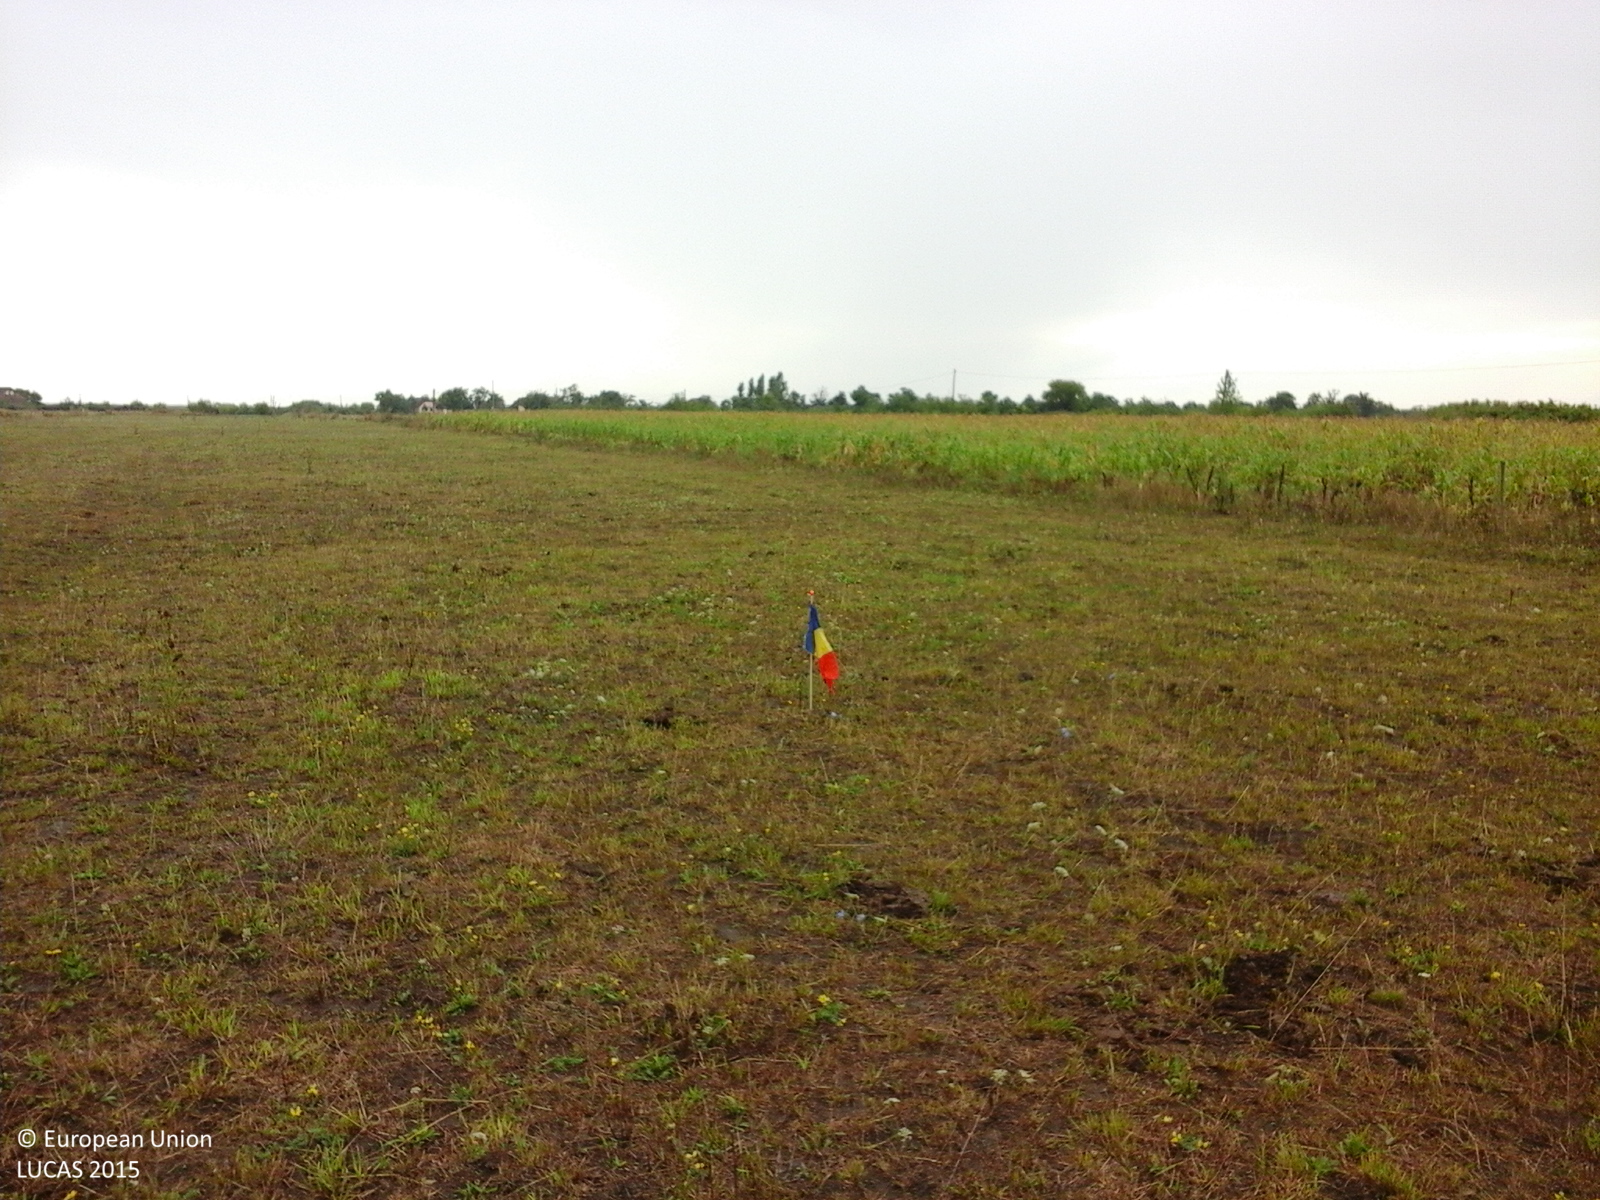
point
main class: Grassland
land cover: Grassland without tree/shrub cover
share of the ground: > 75 %
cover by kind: herbaceous plants 100 %
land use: Agriculture (excluding fallow land and kitchen gardens)
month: August
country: RO
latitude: 45.6450
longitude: 20.9198
